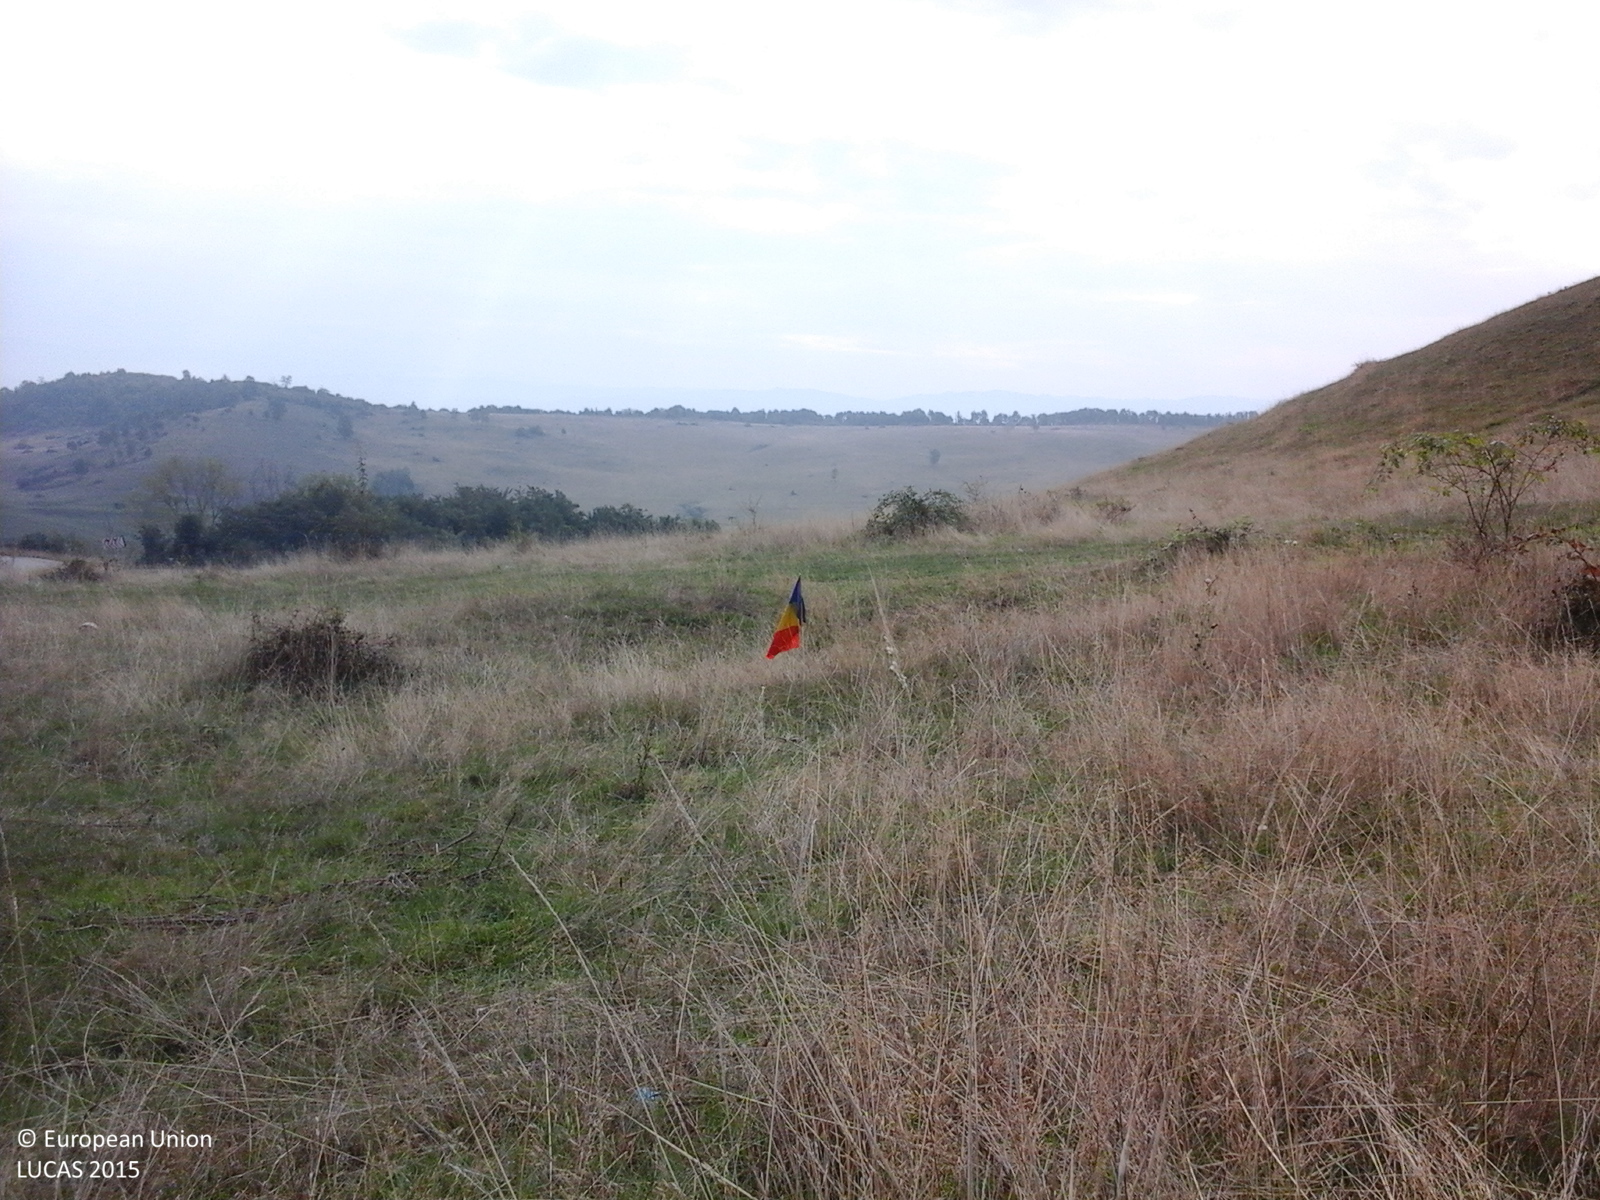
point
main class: Grassland
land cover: Grassland without tree/shrub cover
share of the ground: > 75 %
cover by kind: herbaceous plants 100 %
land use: Agriculture (excluding fallow land and kitchen gardens)
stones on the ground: < 10 %
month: September
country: RO
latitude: 45.6930
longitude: 22.9071
